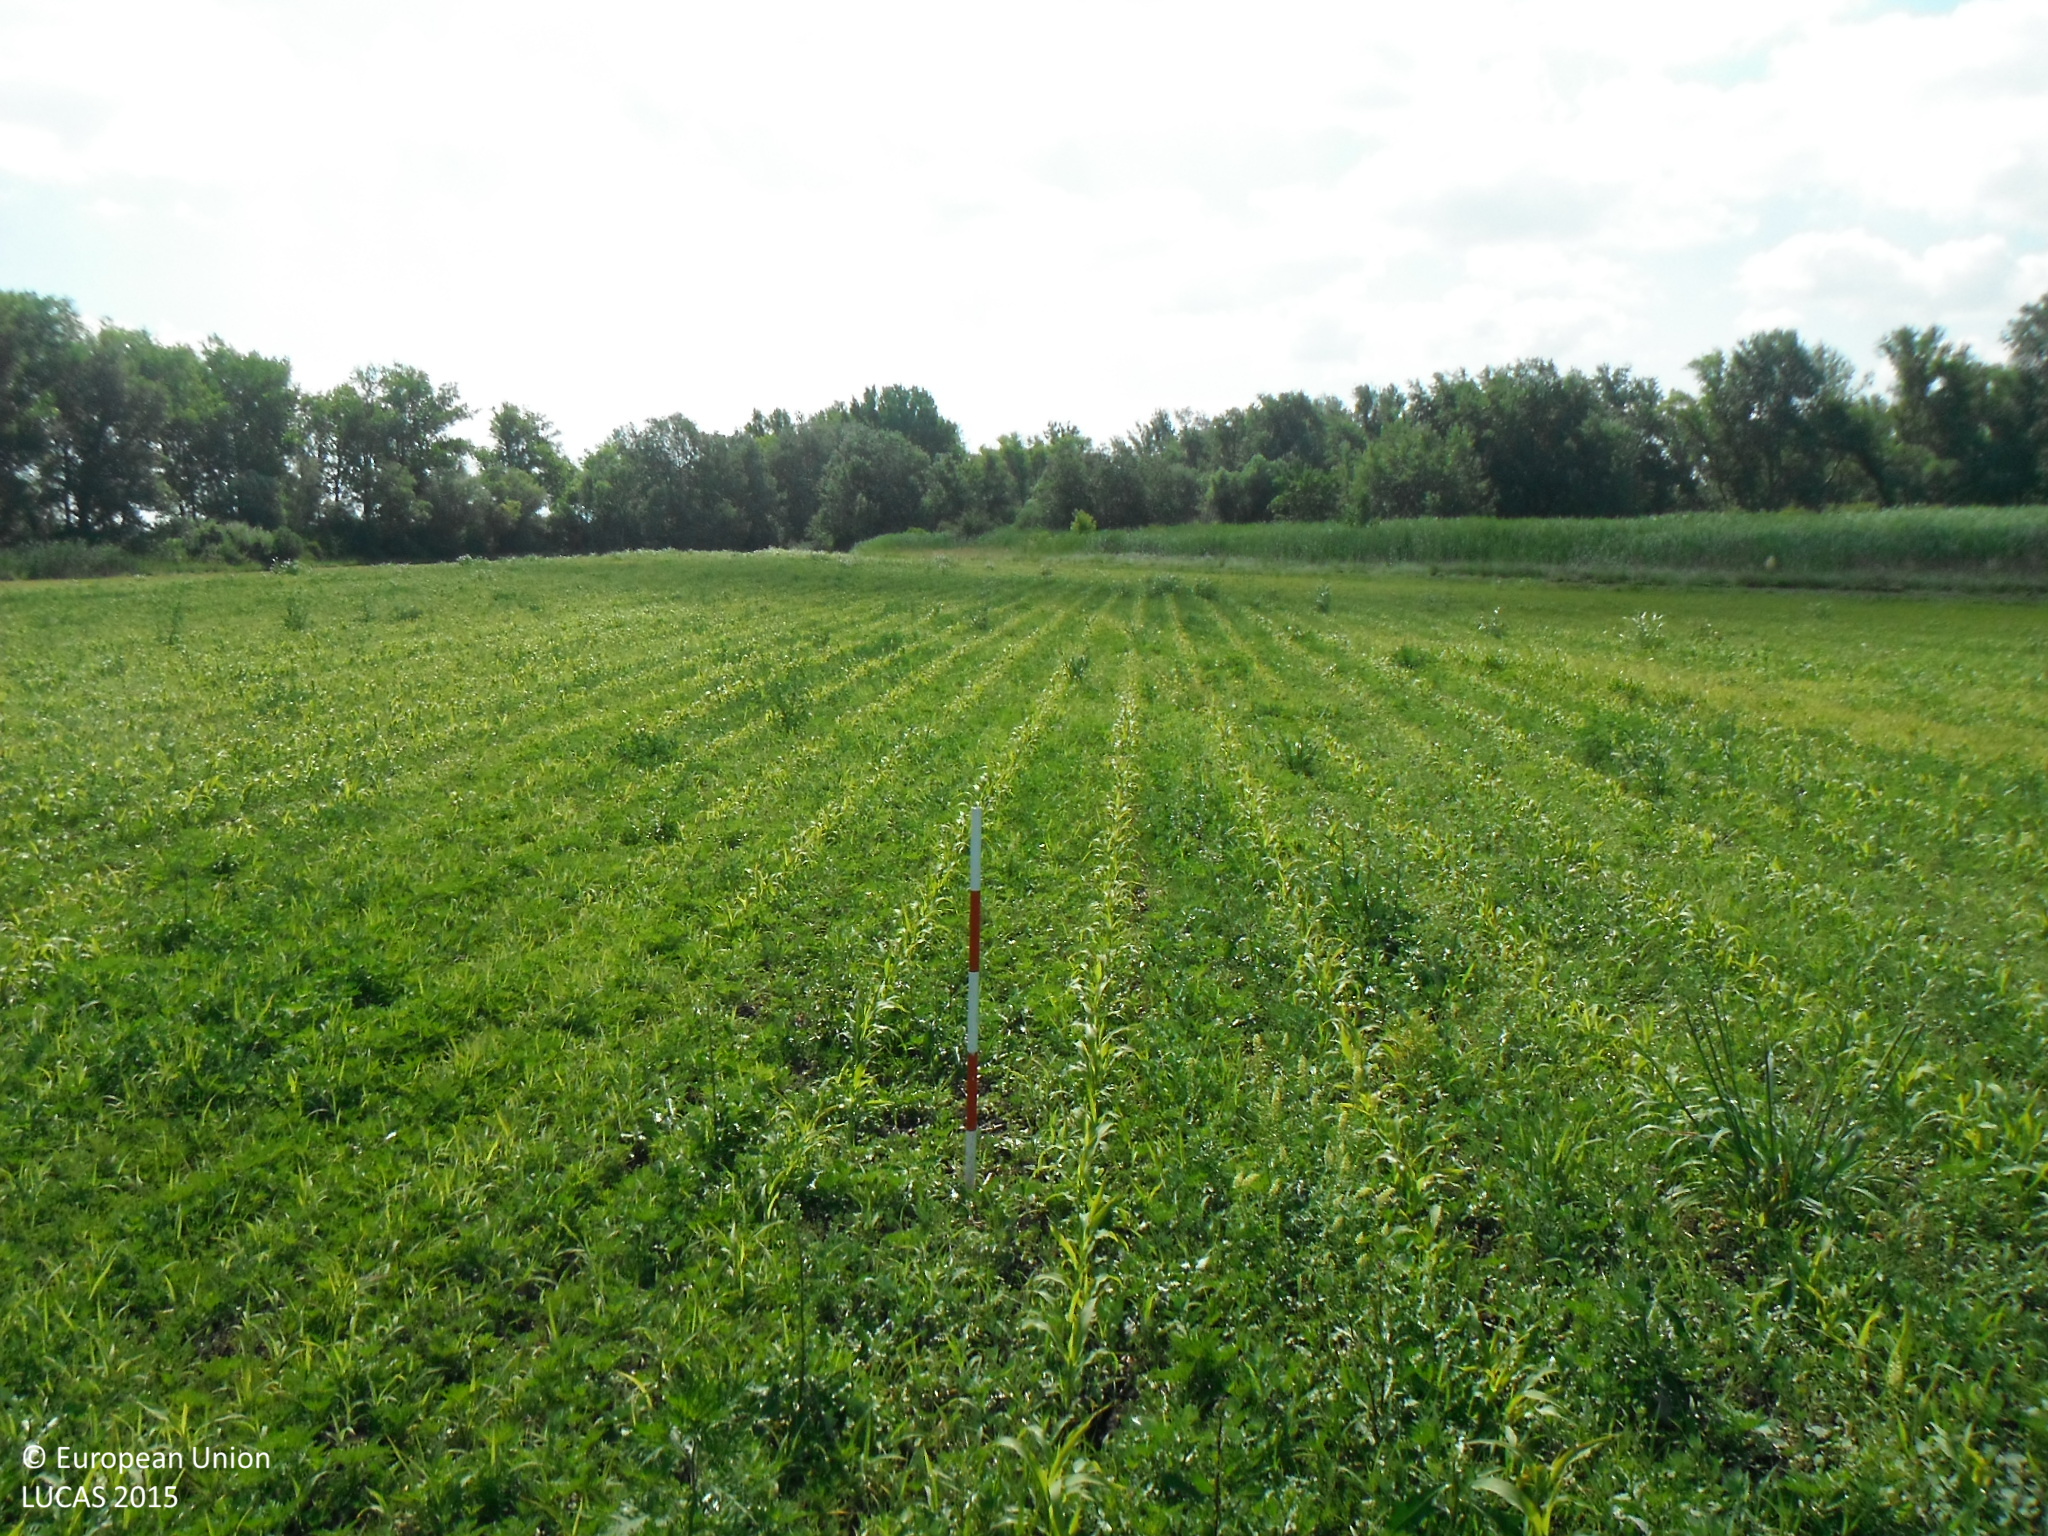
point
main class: Cropland
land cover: Maize
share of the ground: 10 - 25 %
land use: Agriculture (excluding fallow land and kitchen gardens)
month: June
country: SK
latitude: 47.7557
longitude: 18.1901
